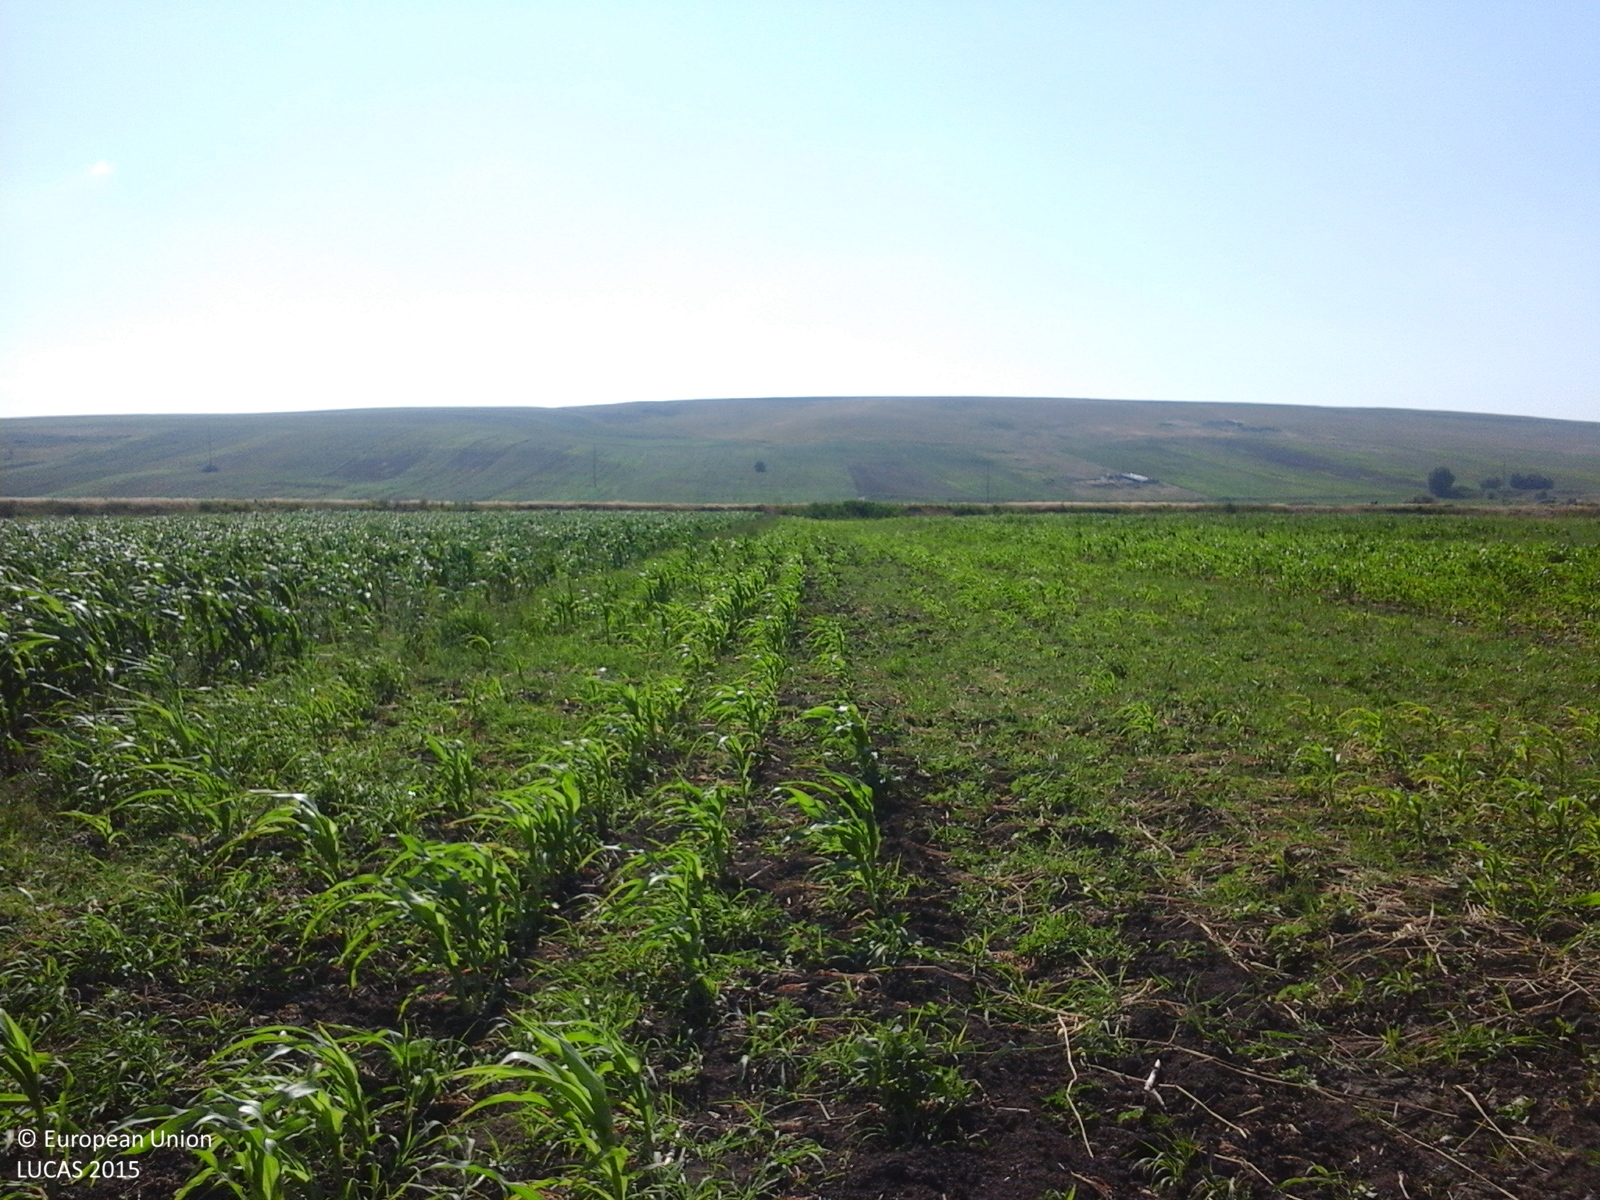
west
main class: Cropland
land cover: Maize
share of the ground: 10 - 25 %
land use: Agriculture (excluding fallow land and kitchen gardens)
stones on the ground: < 10 %
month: June
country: RO
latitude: 46.7790
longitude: 27.7903
